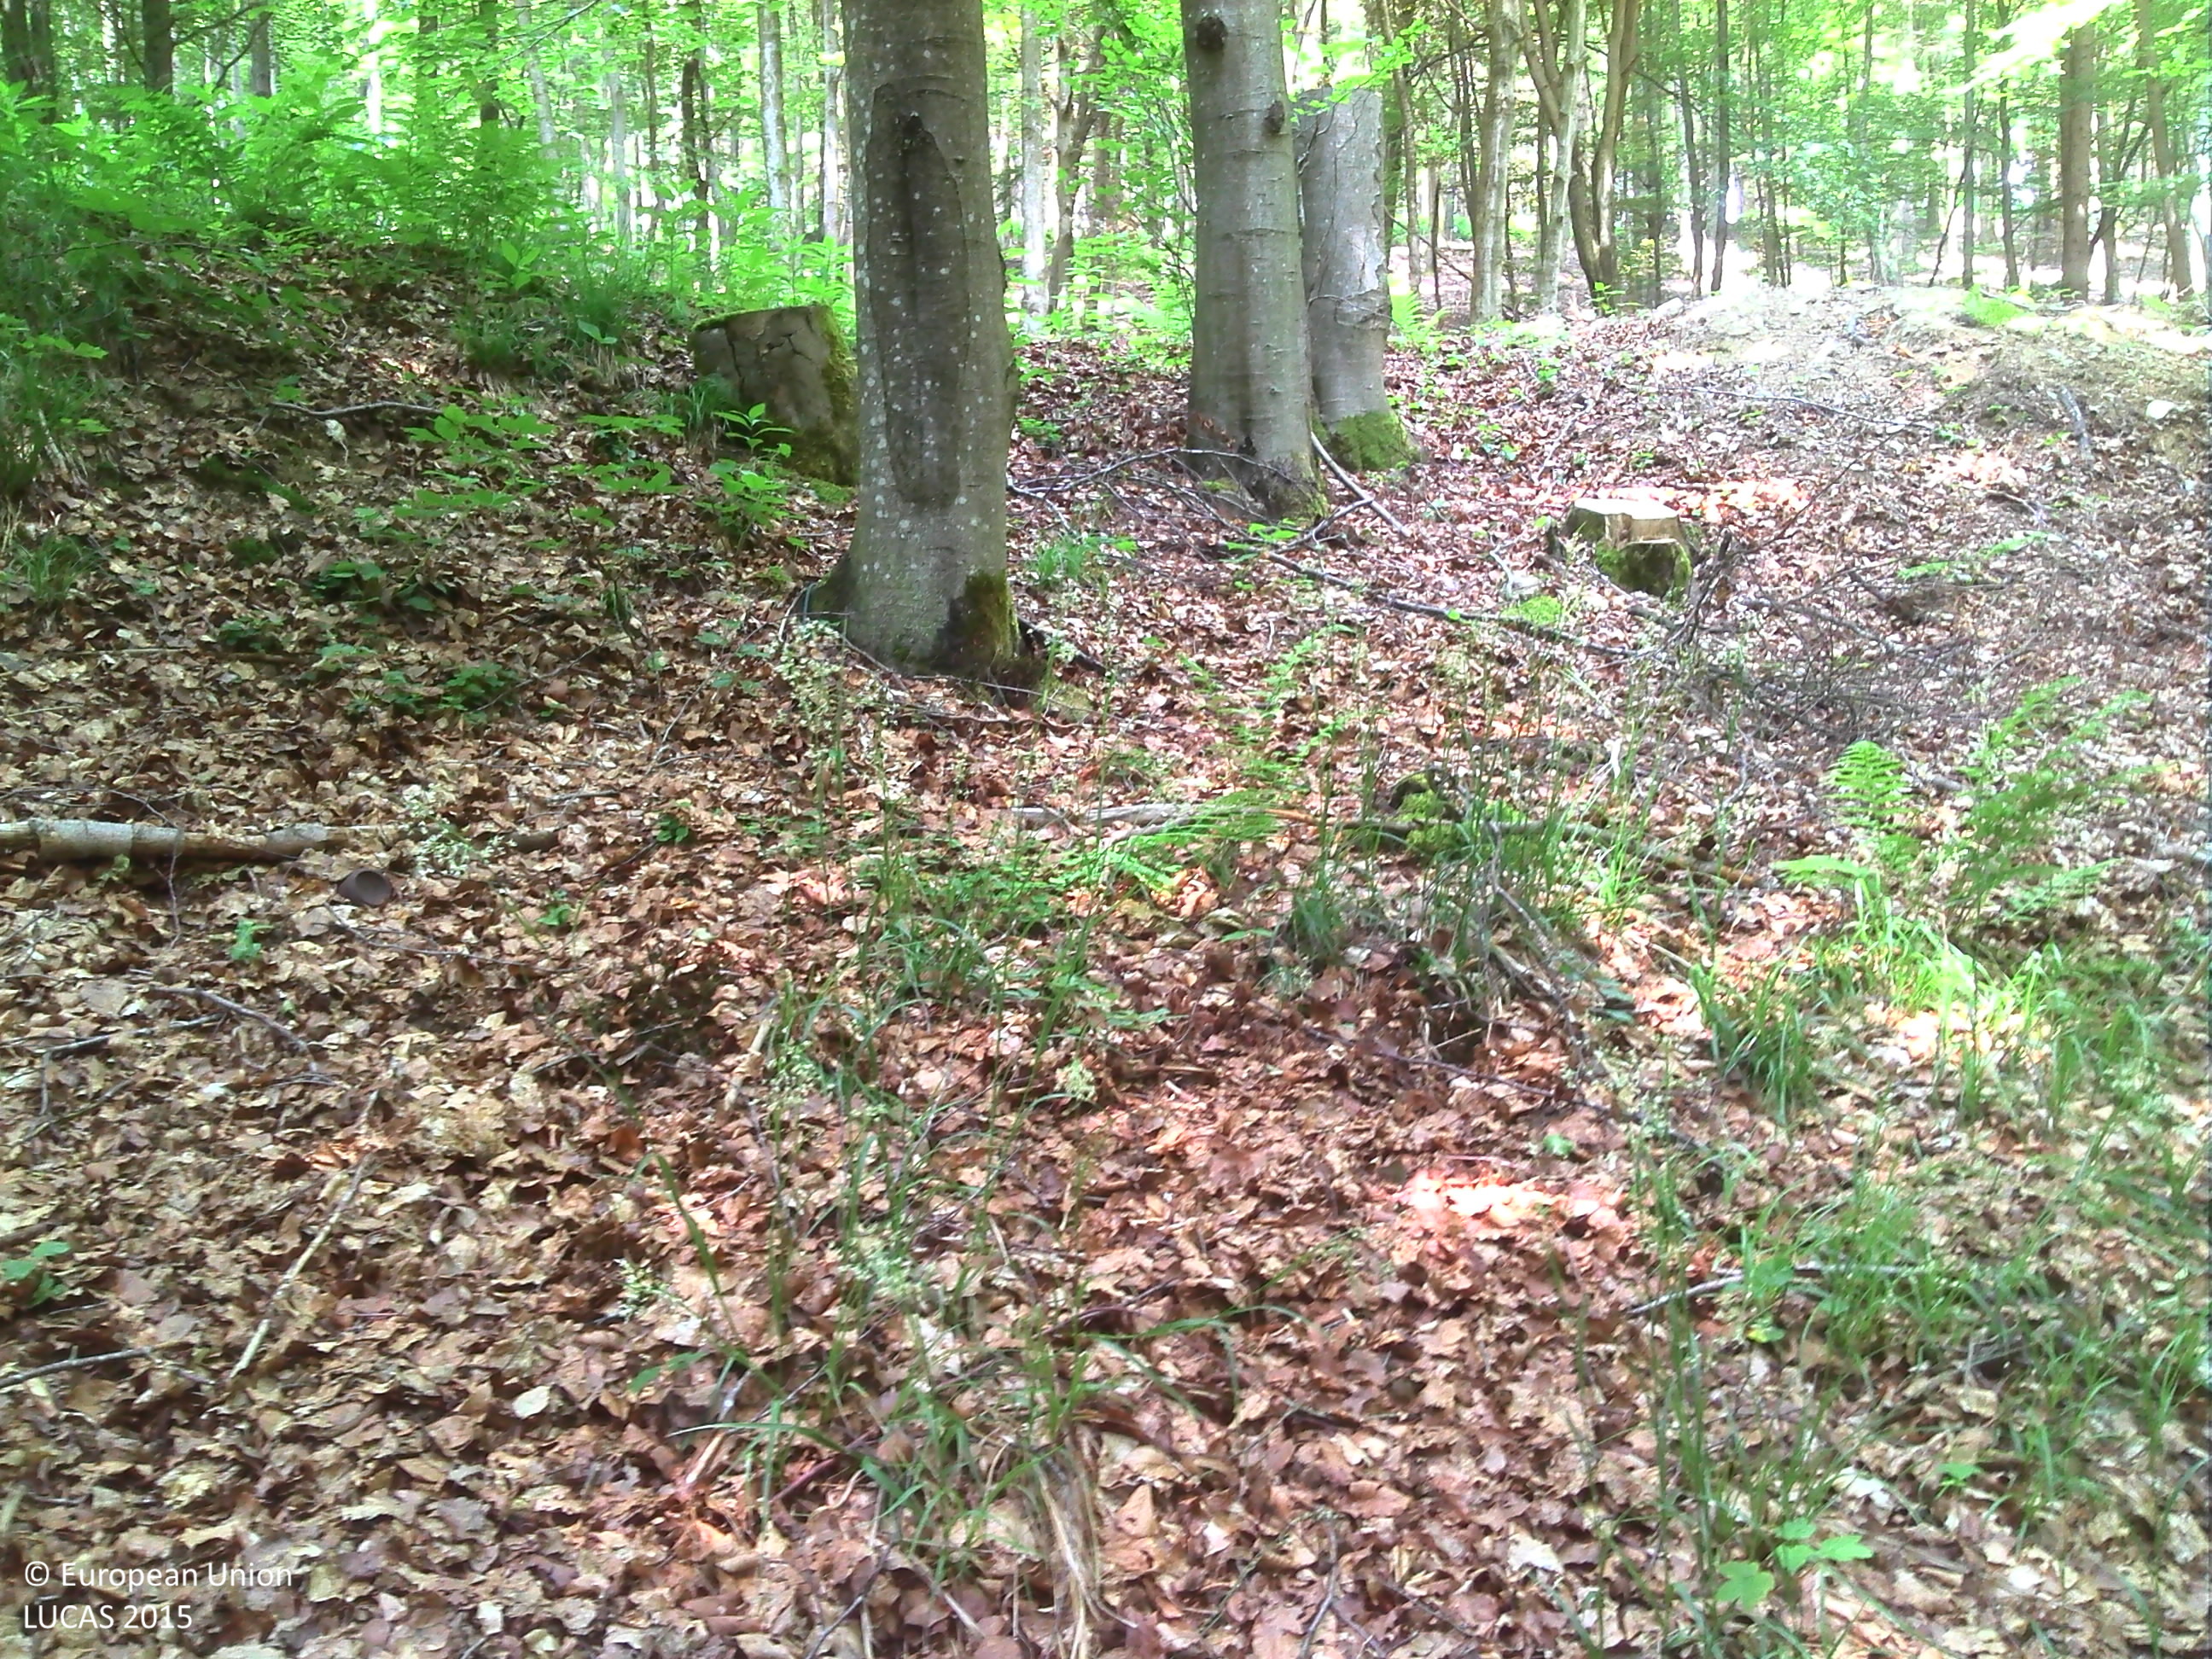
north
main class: Woodland
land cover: Broadleaved woodland
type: beech forest
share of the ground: > 75 %
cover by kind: broadleaved forest trees 100 %
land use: Forestry
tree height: > 5 m
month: June
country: BE
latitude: 50.3924
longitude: 6.2436
